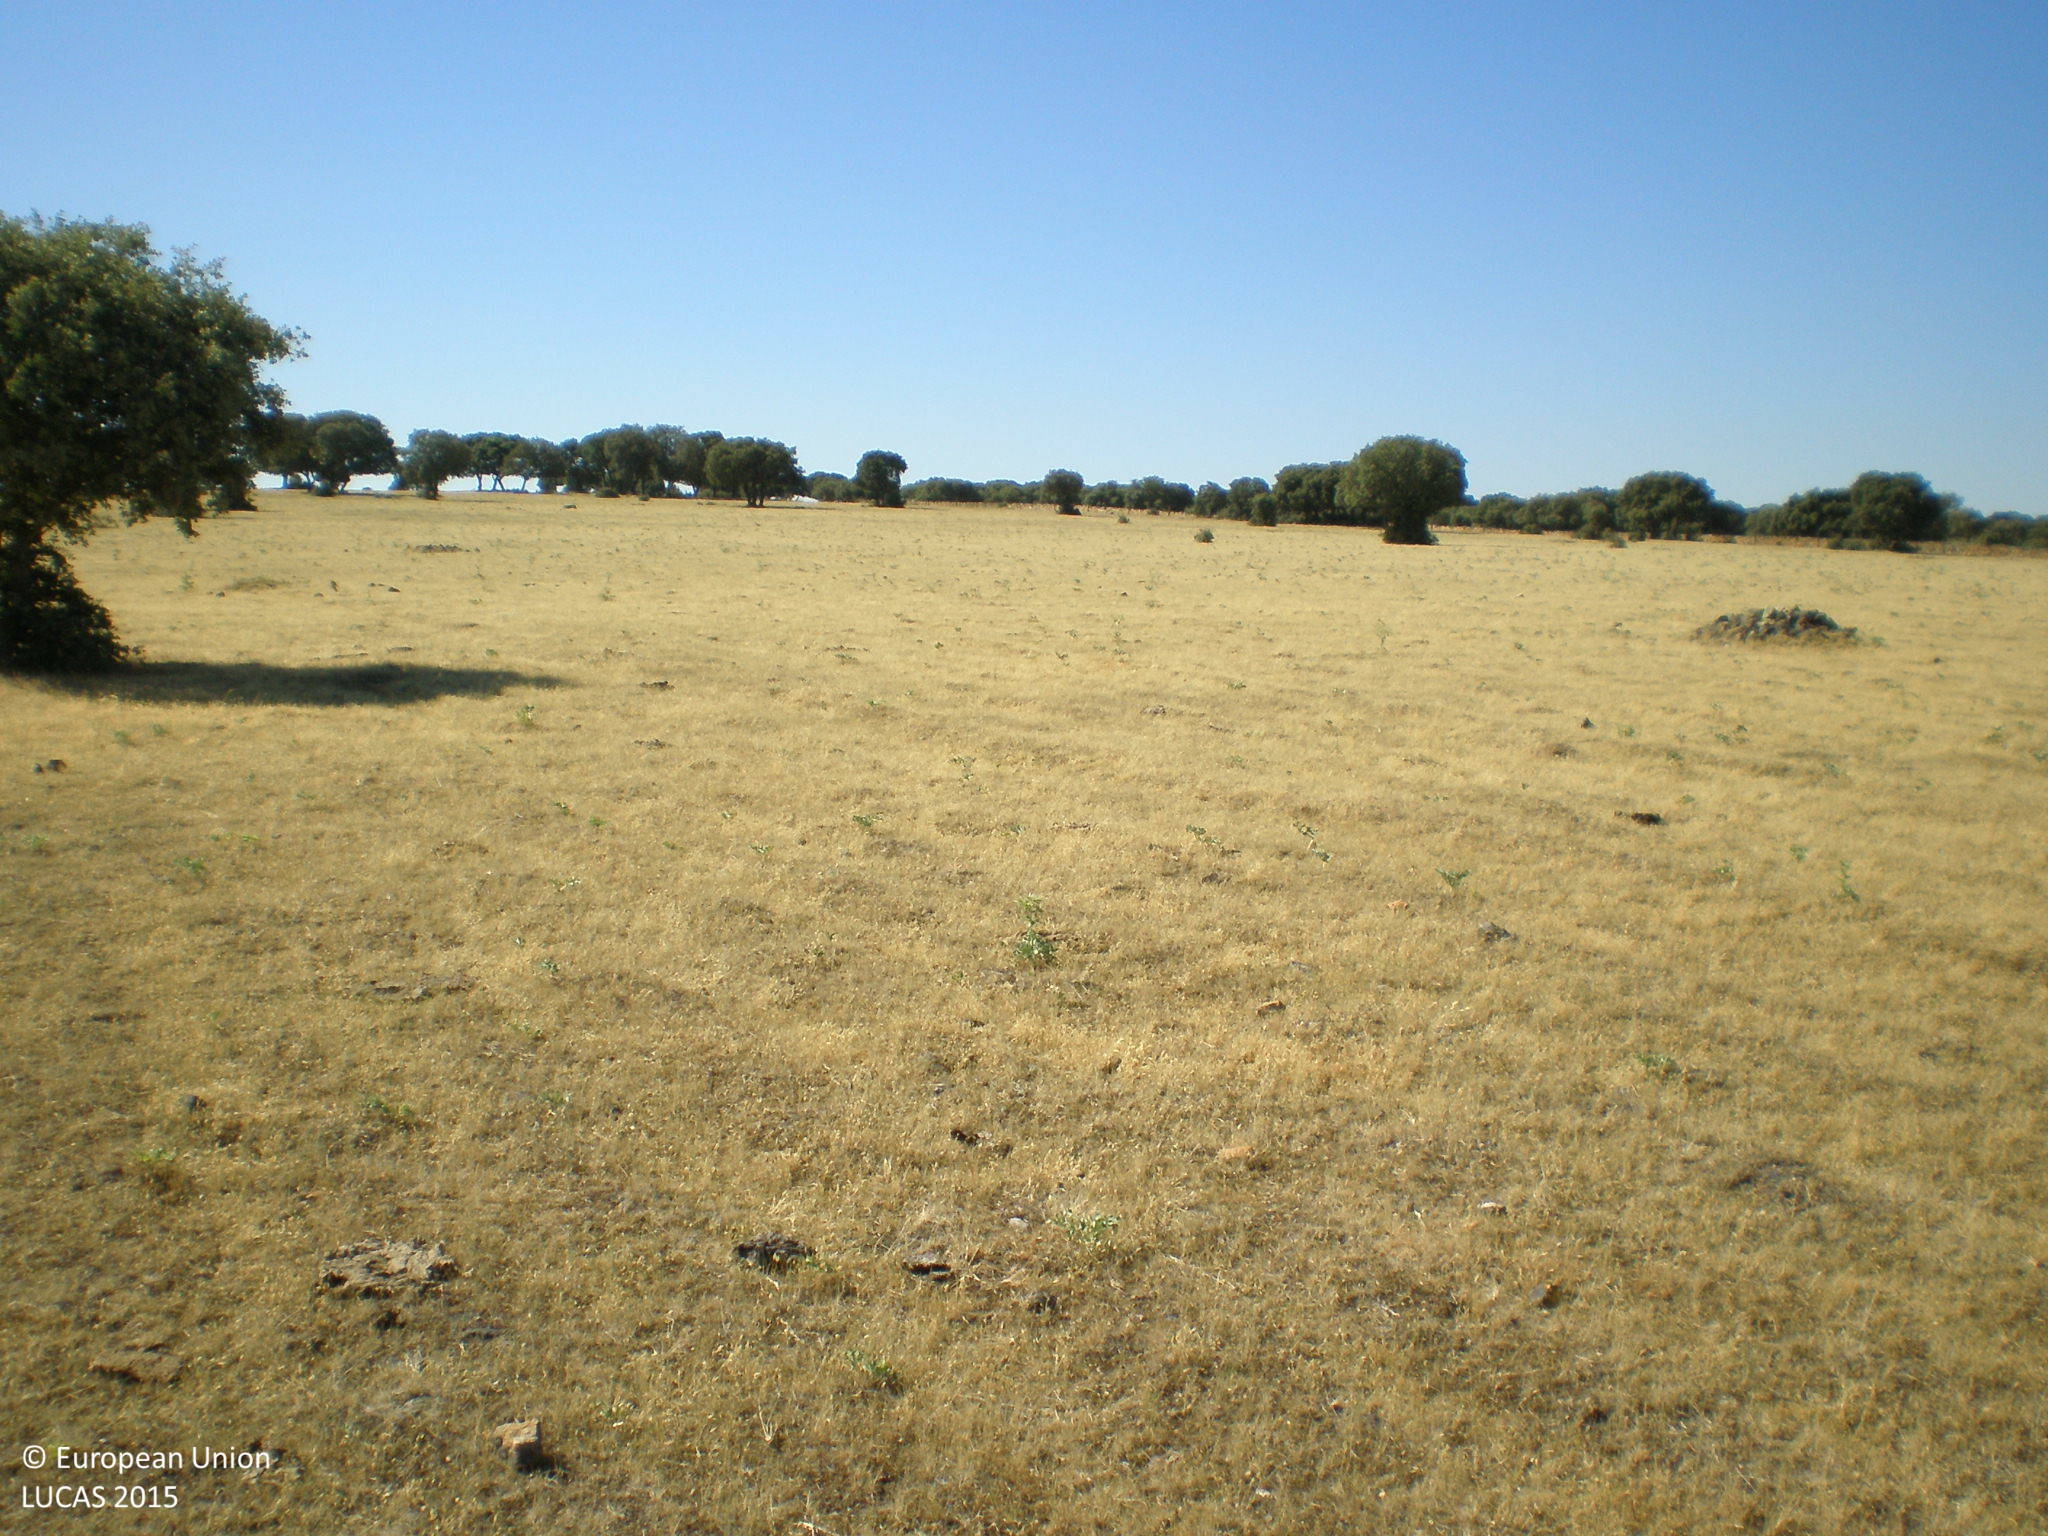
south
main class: Grassland
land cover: Grassland with sparse tree/shrub cover
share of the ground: > 75 %
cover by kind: herbaceous plants 95 %, broadleaved forest trees 5 %
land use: Agriculture (excluding fallow land and kitchen gardens)
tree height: < 5 m
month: June
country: ES
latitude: 40.7986
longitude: -5.6850
